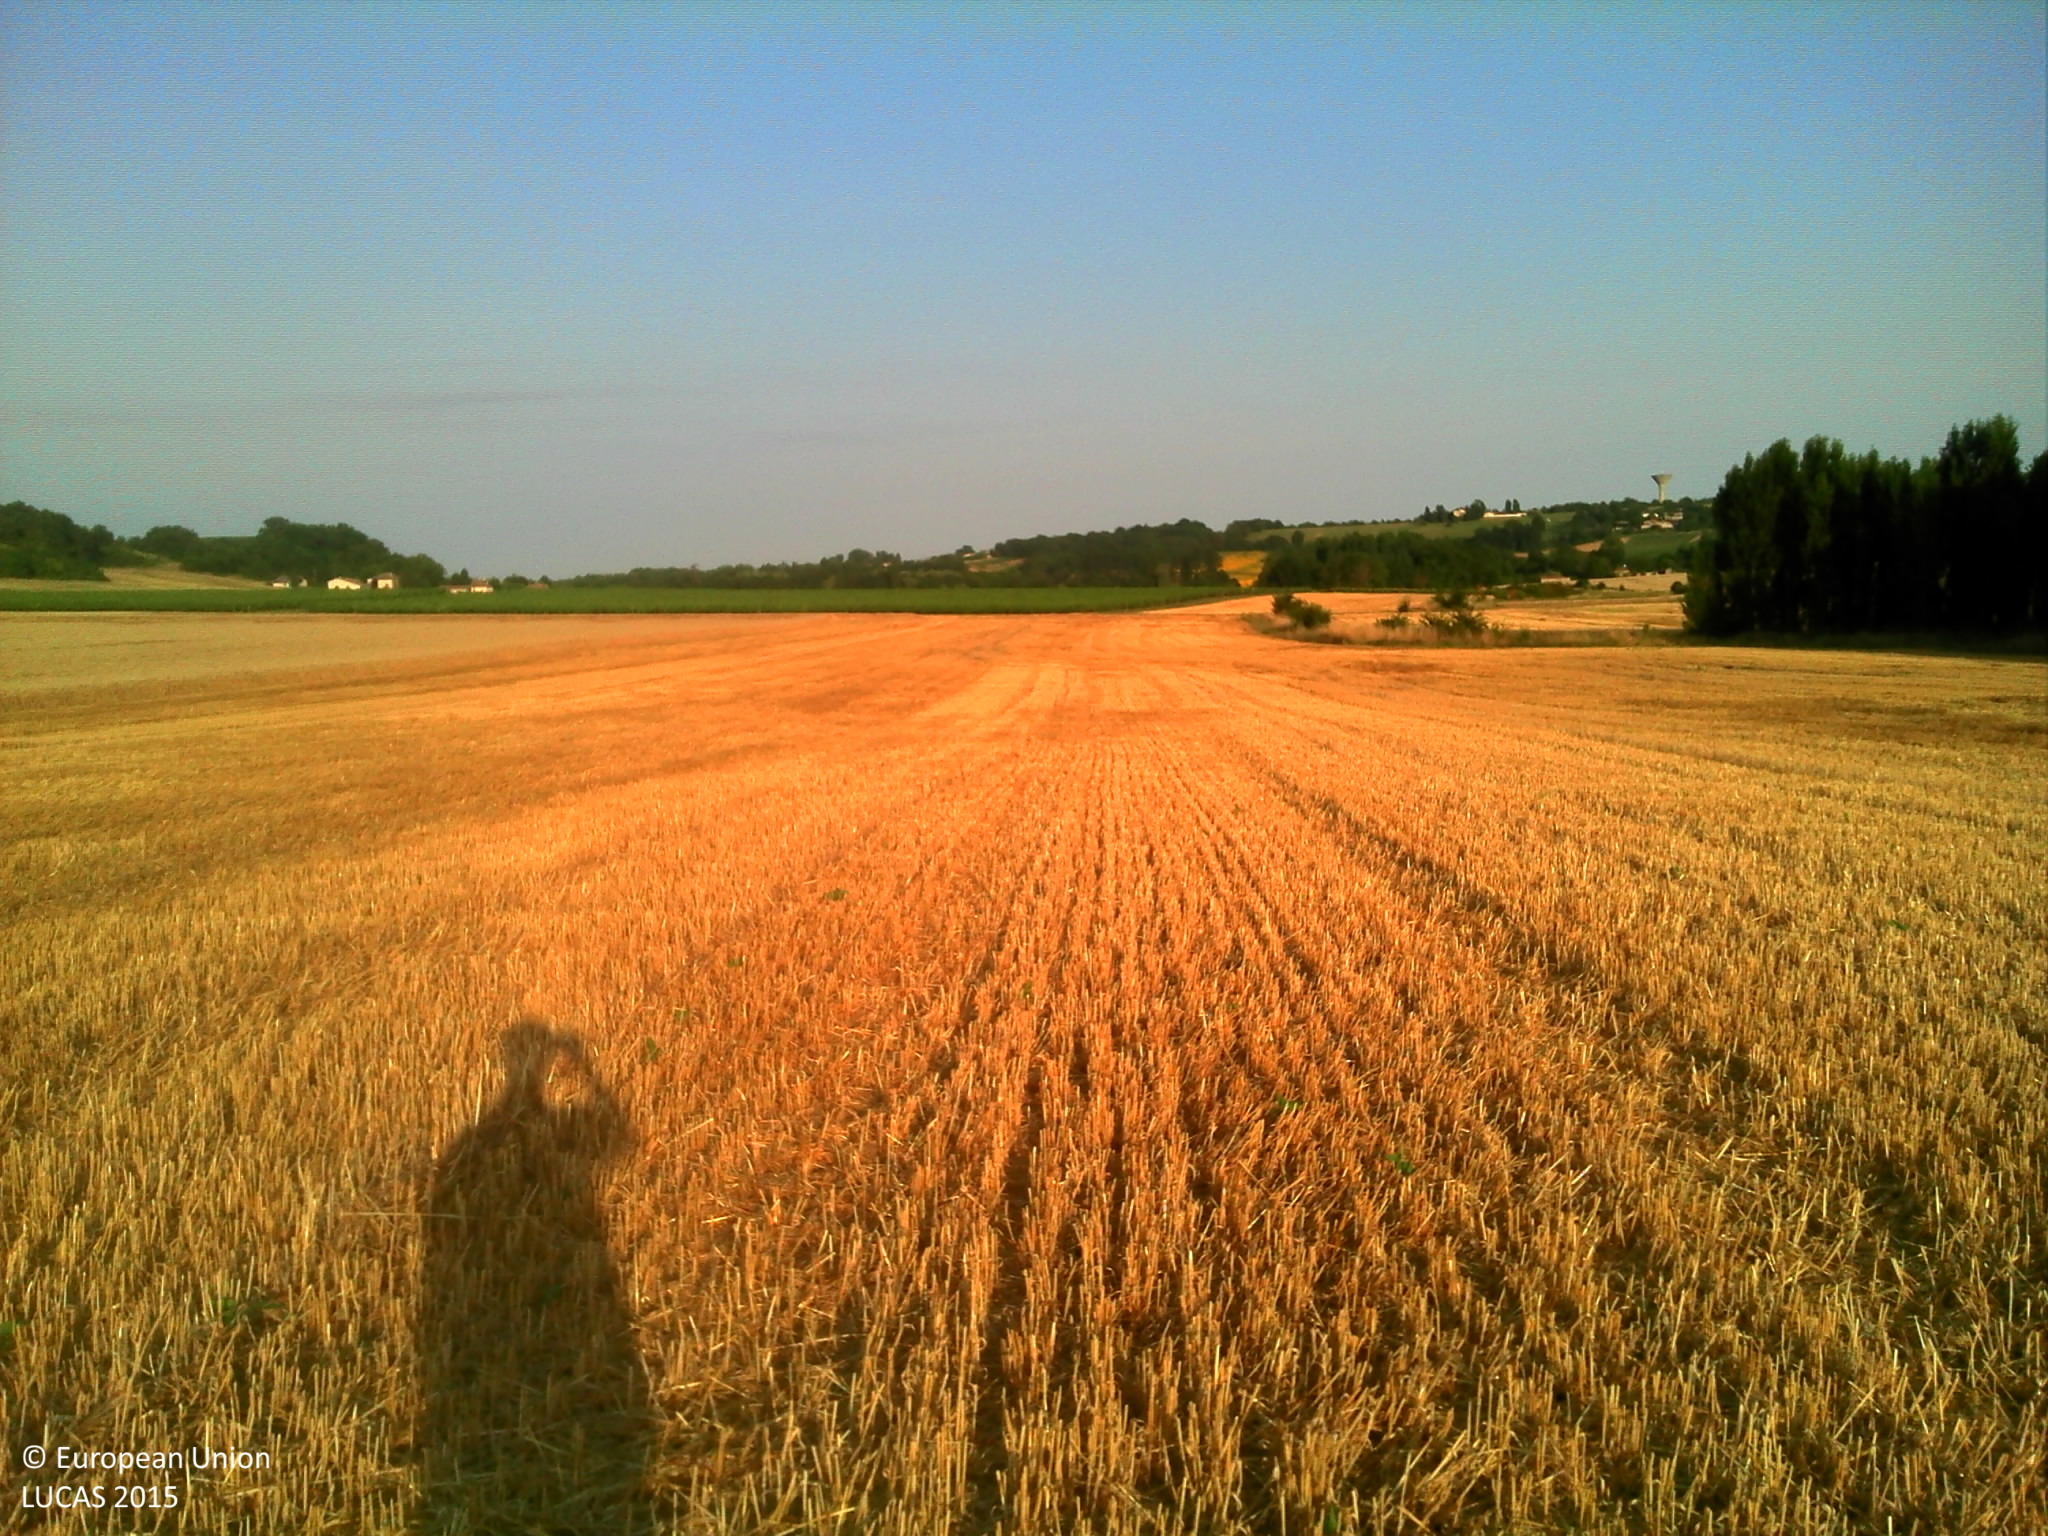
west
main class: Cropland
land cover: Durum wheat
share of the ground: > 75 %
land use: Agriculture (excluding fallow land and kitchen gardens)
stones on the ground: < 10 %
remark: Harvested field
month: July
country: FR
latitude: 45.3657
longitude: -0.6317
